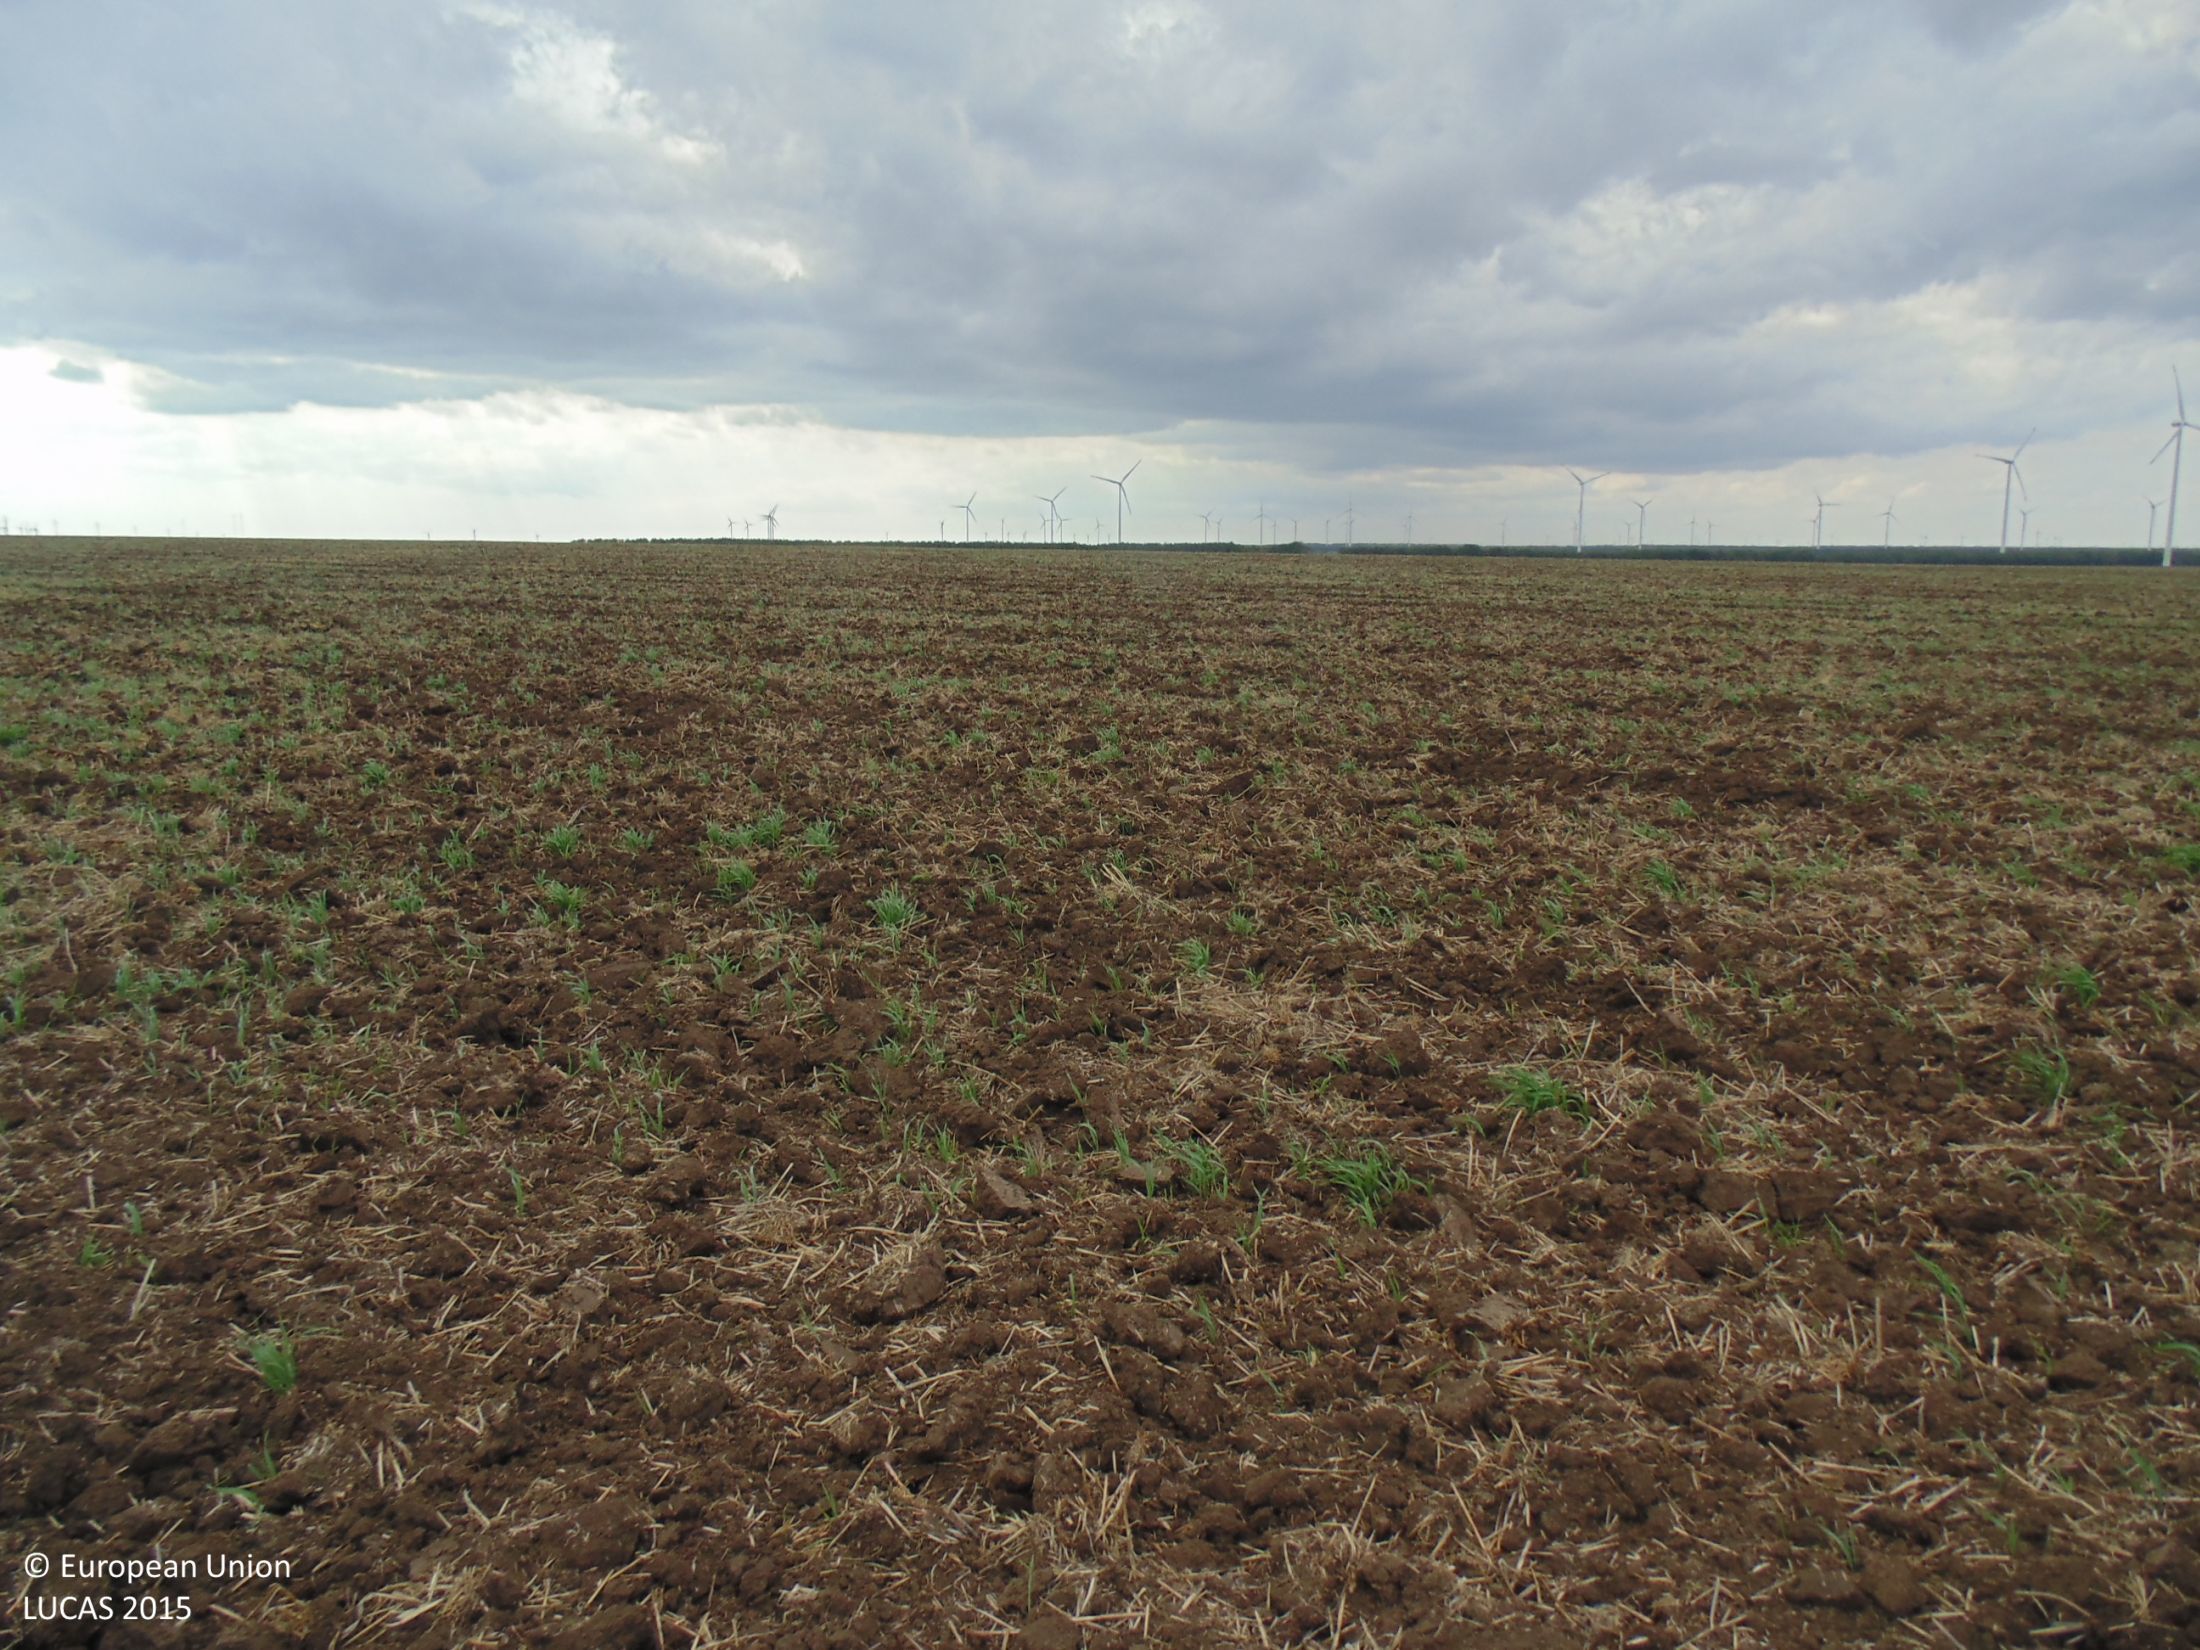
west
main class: Cropland
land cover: Common wheat
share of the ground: < 10 %
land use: Agriculture (excluding fallow land and kitchen gardens)
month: September
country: BG
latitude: 43.4432
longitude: 28.5090
